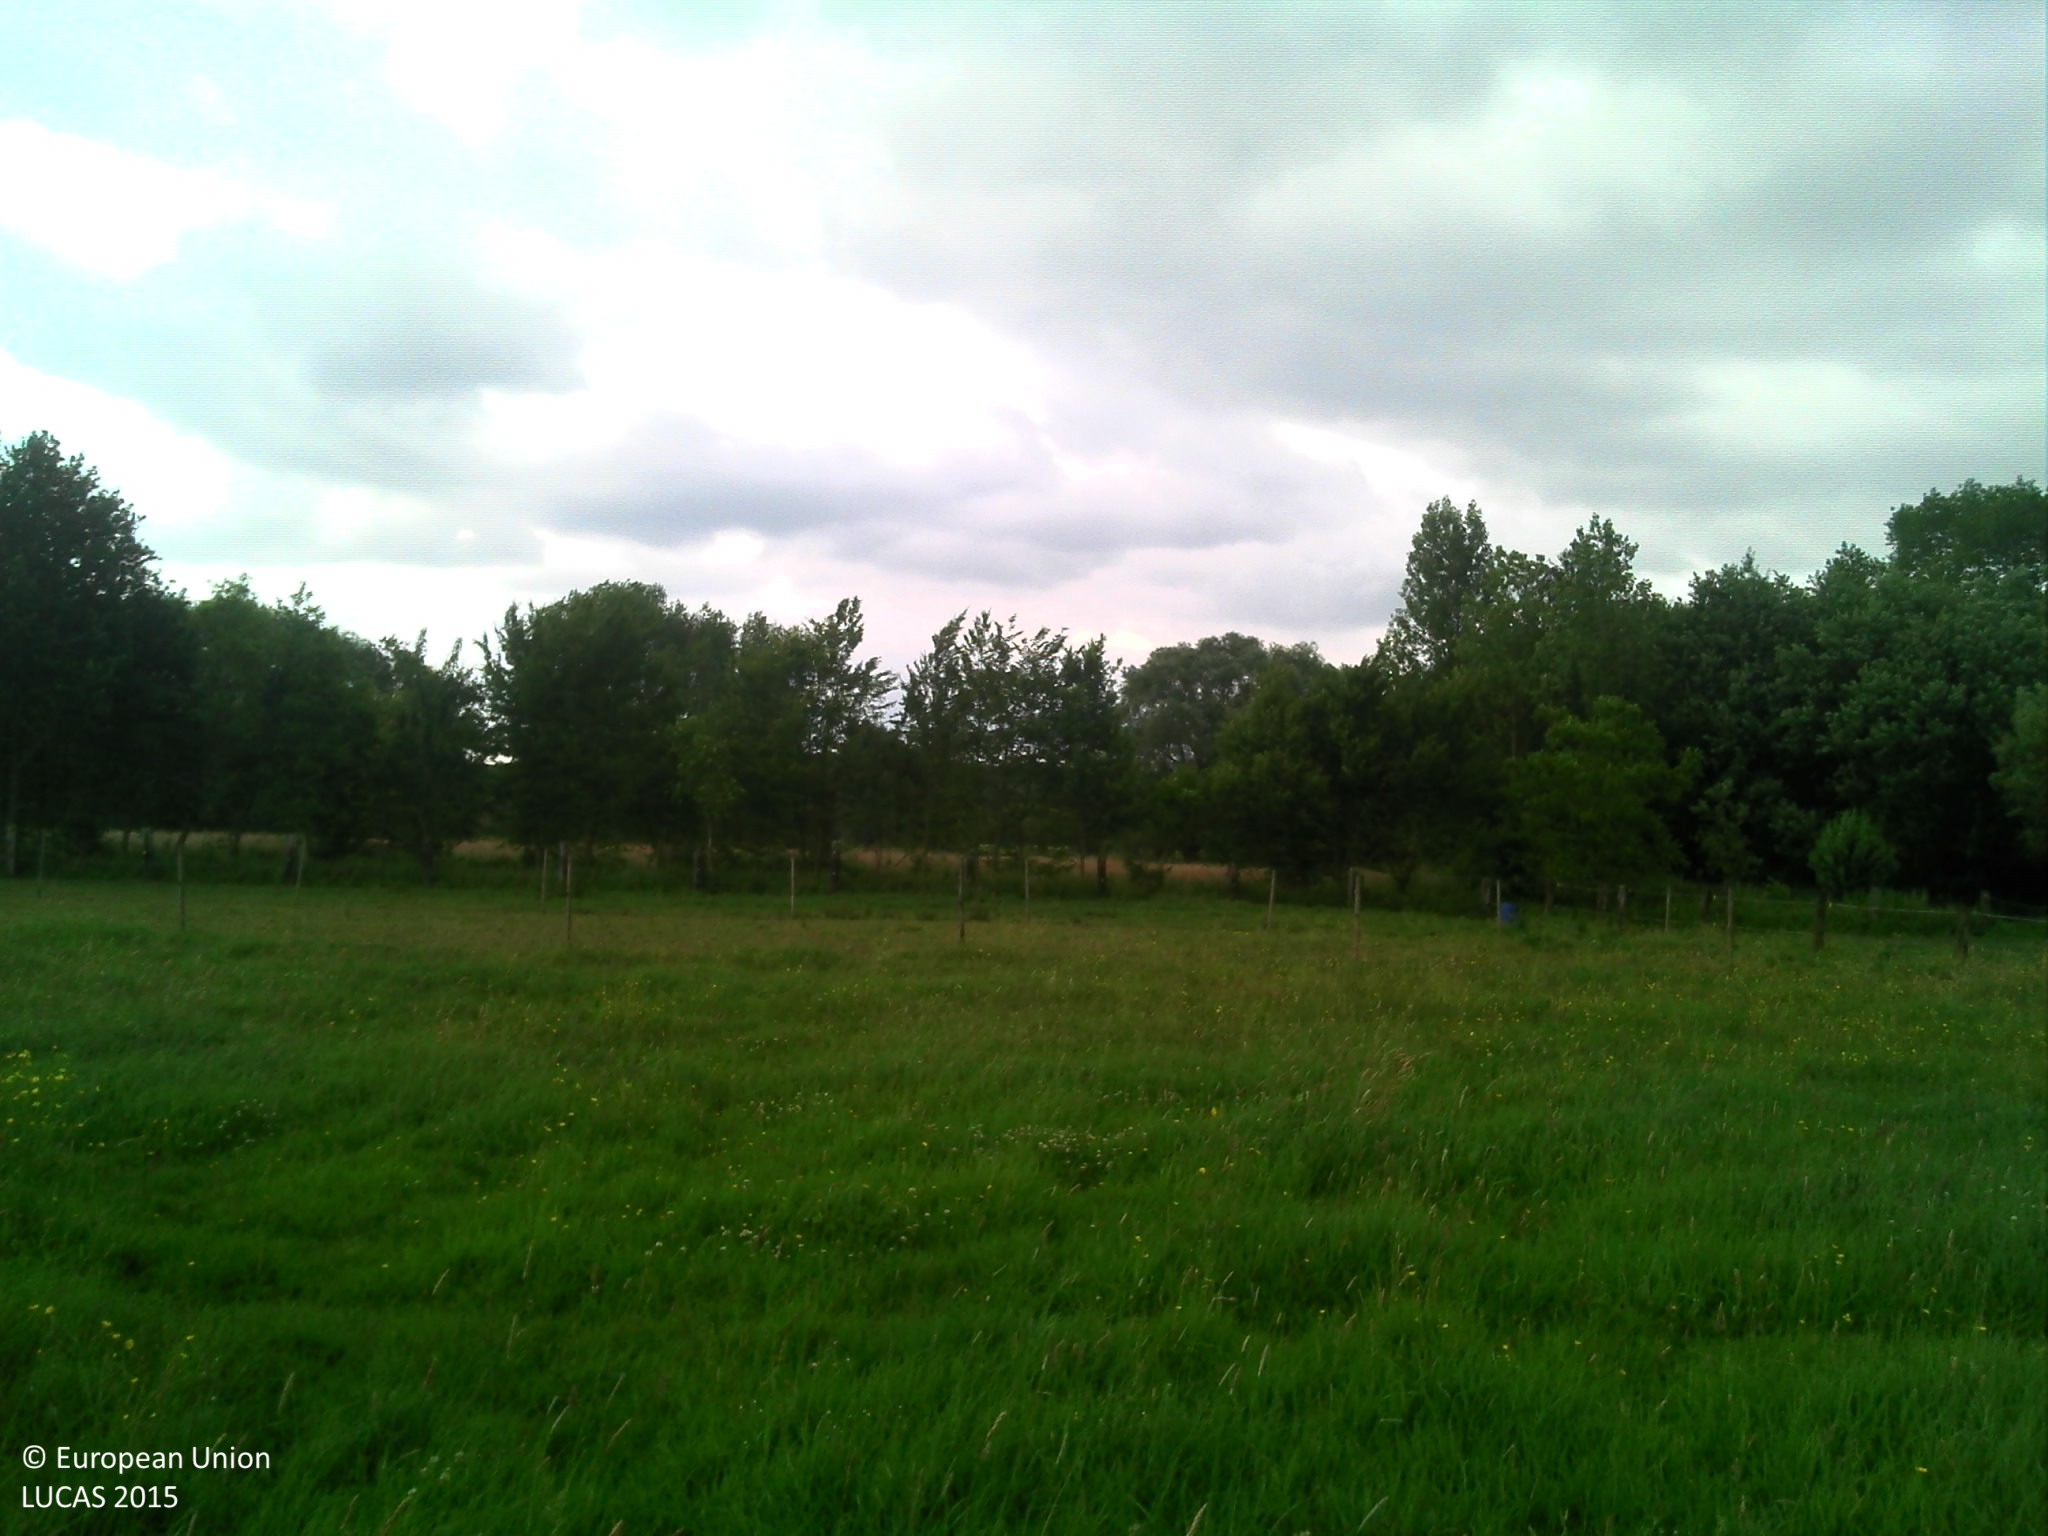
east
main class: Grassland
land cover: Grassland without tree/shrub cover
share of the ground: > 75 %
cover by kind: herbaceous plants 100 %
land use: Agriculture (excluding fallow land and kitchen gardens)
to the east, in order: Grassland without tree/shrub cover; Fences; Rivers and streams; Managed hedges; Tracks; Fences; Grassland without tree/shrub cover; Fences; Lines of trees; Rivers and streams; Fences; Grassland without tree/shrub cover; Fences; Grassland without tree/shrub cover; Fences; Grassland without tree/shrub cover
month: June
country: BE
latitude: 50.9851
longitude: 4.4257
